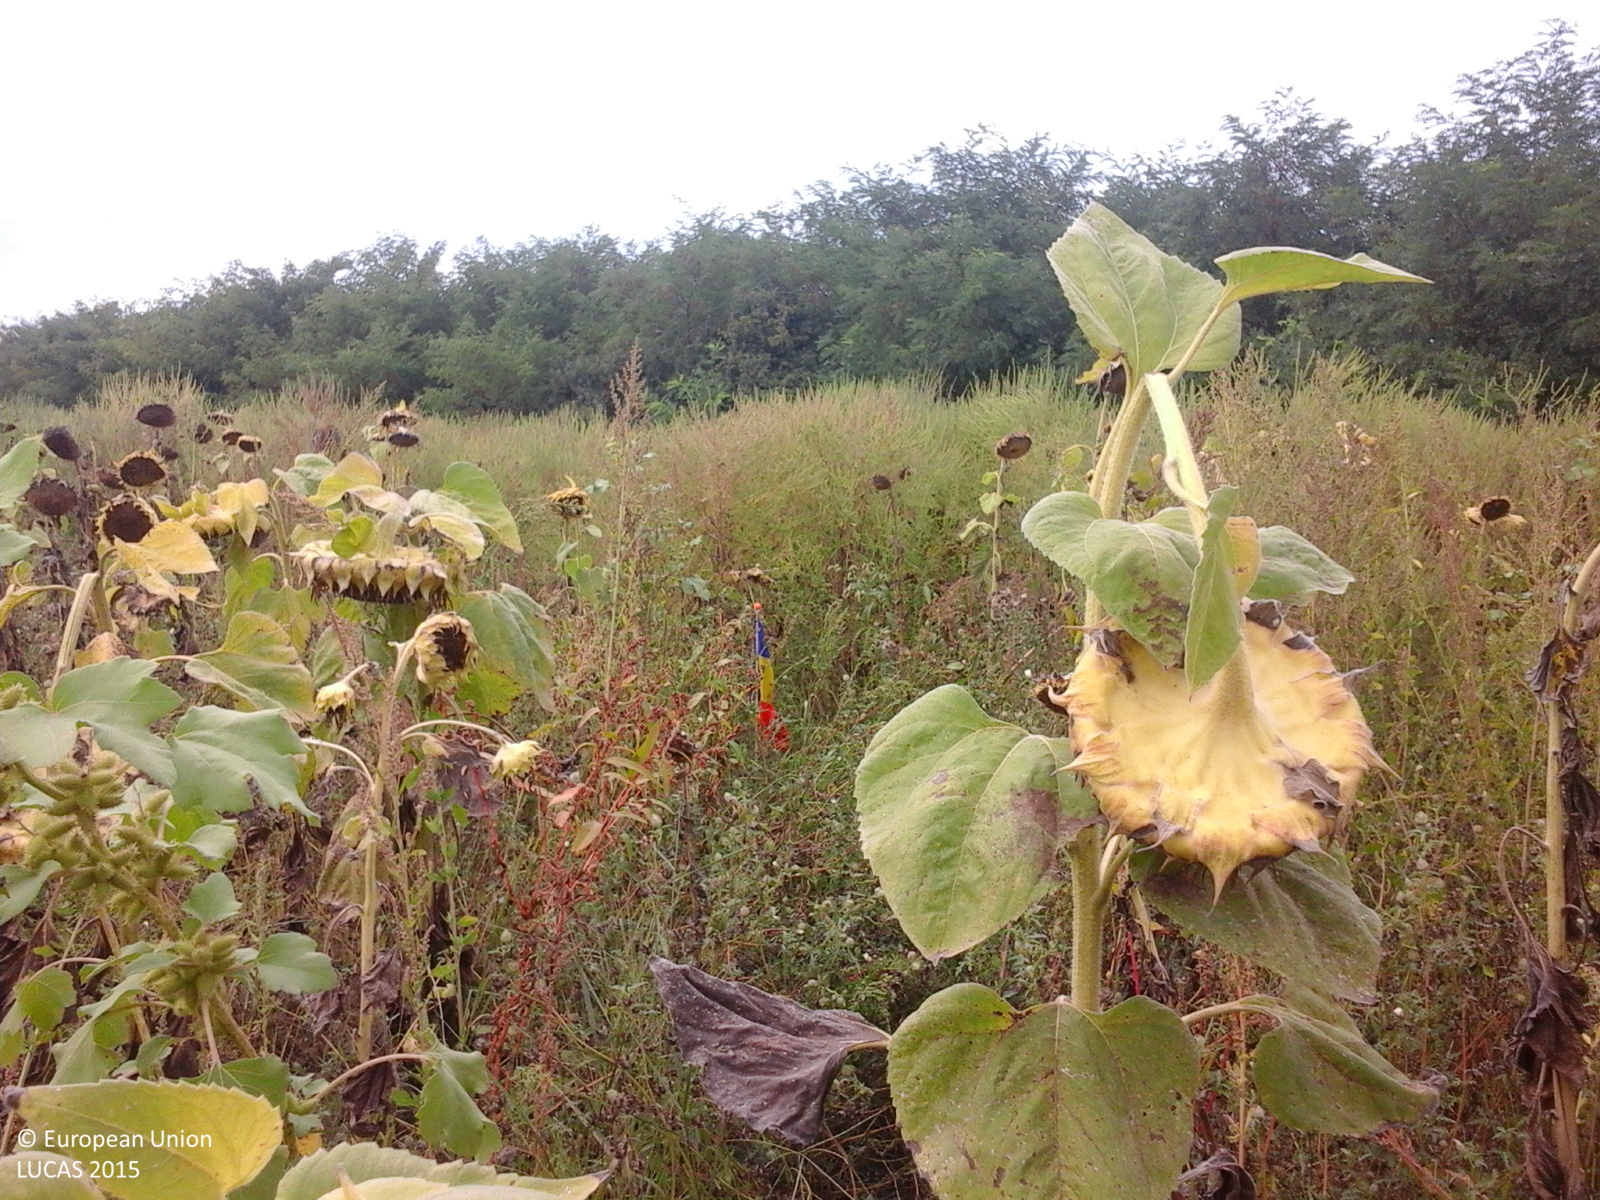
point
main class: Cropland
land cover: Sunflower
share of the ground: 50 - 75 %
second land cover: Spontaneously vegetated surfaces
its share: 25 - 50 %
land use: Agriculture (excluding fallow land and kitchen gardens)
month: September
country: RO
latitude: 47.5145
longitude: 22.6073
